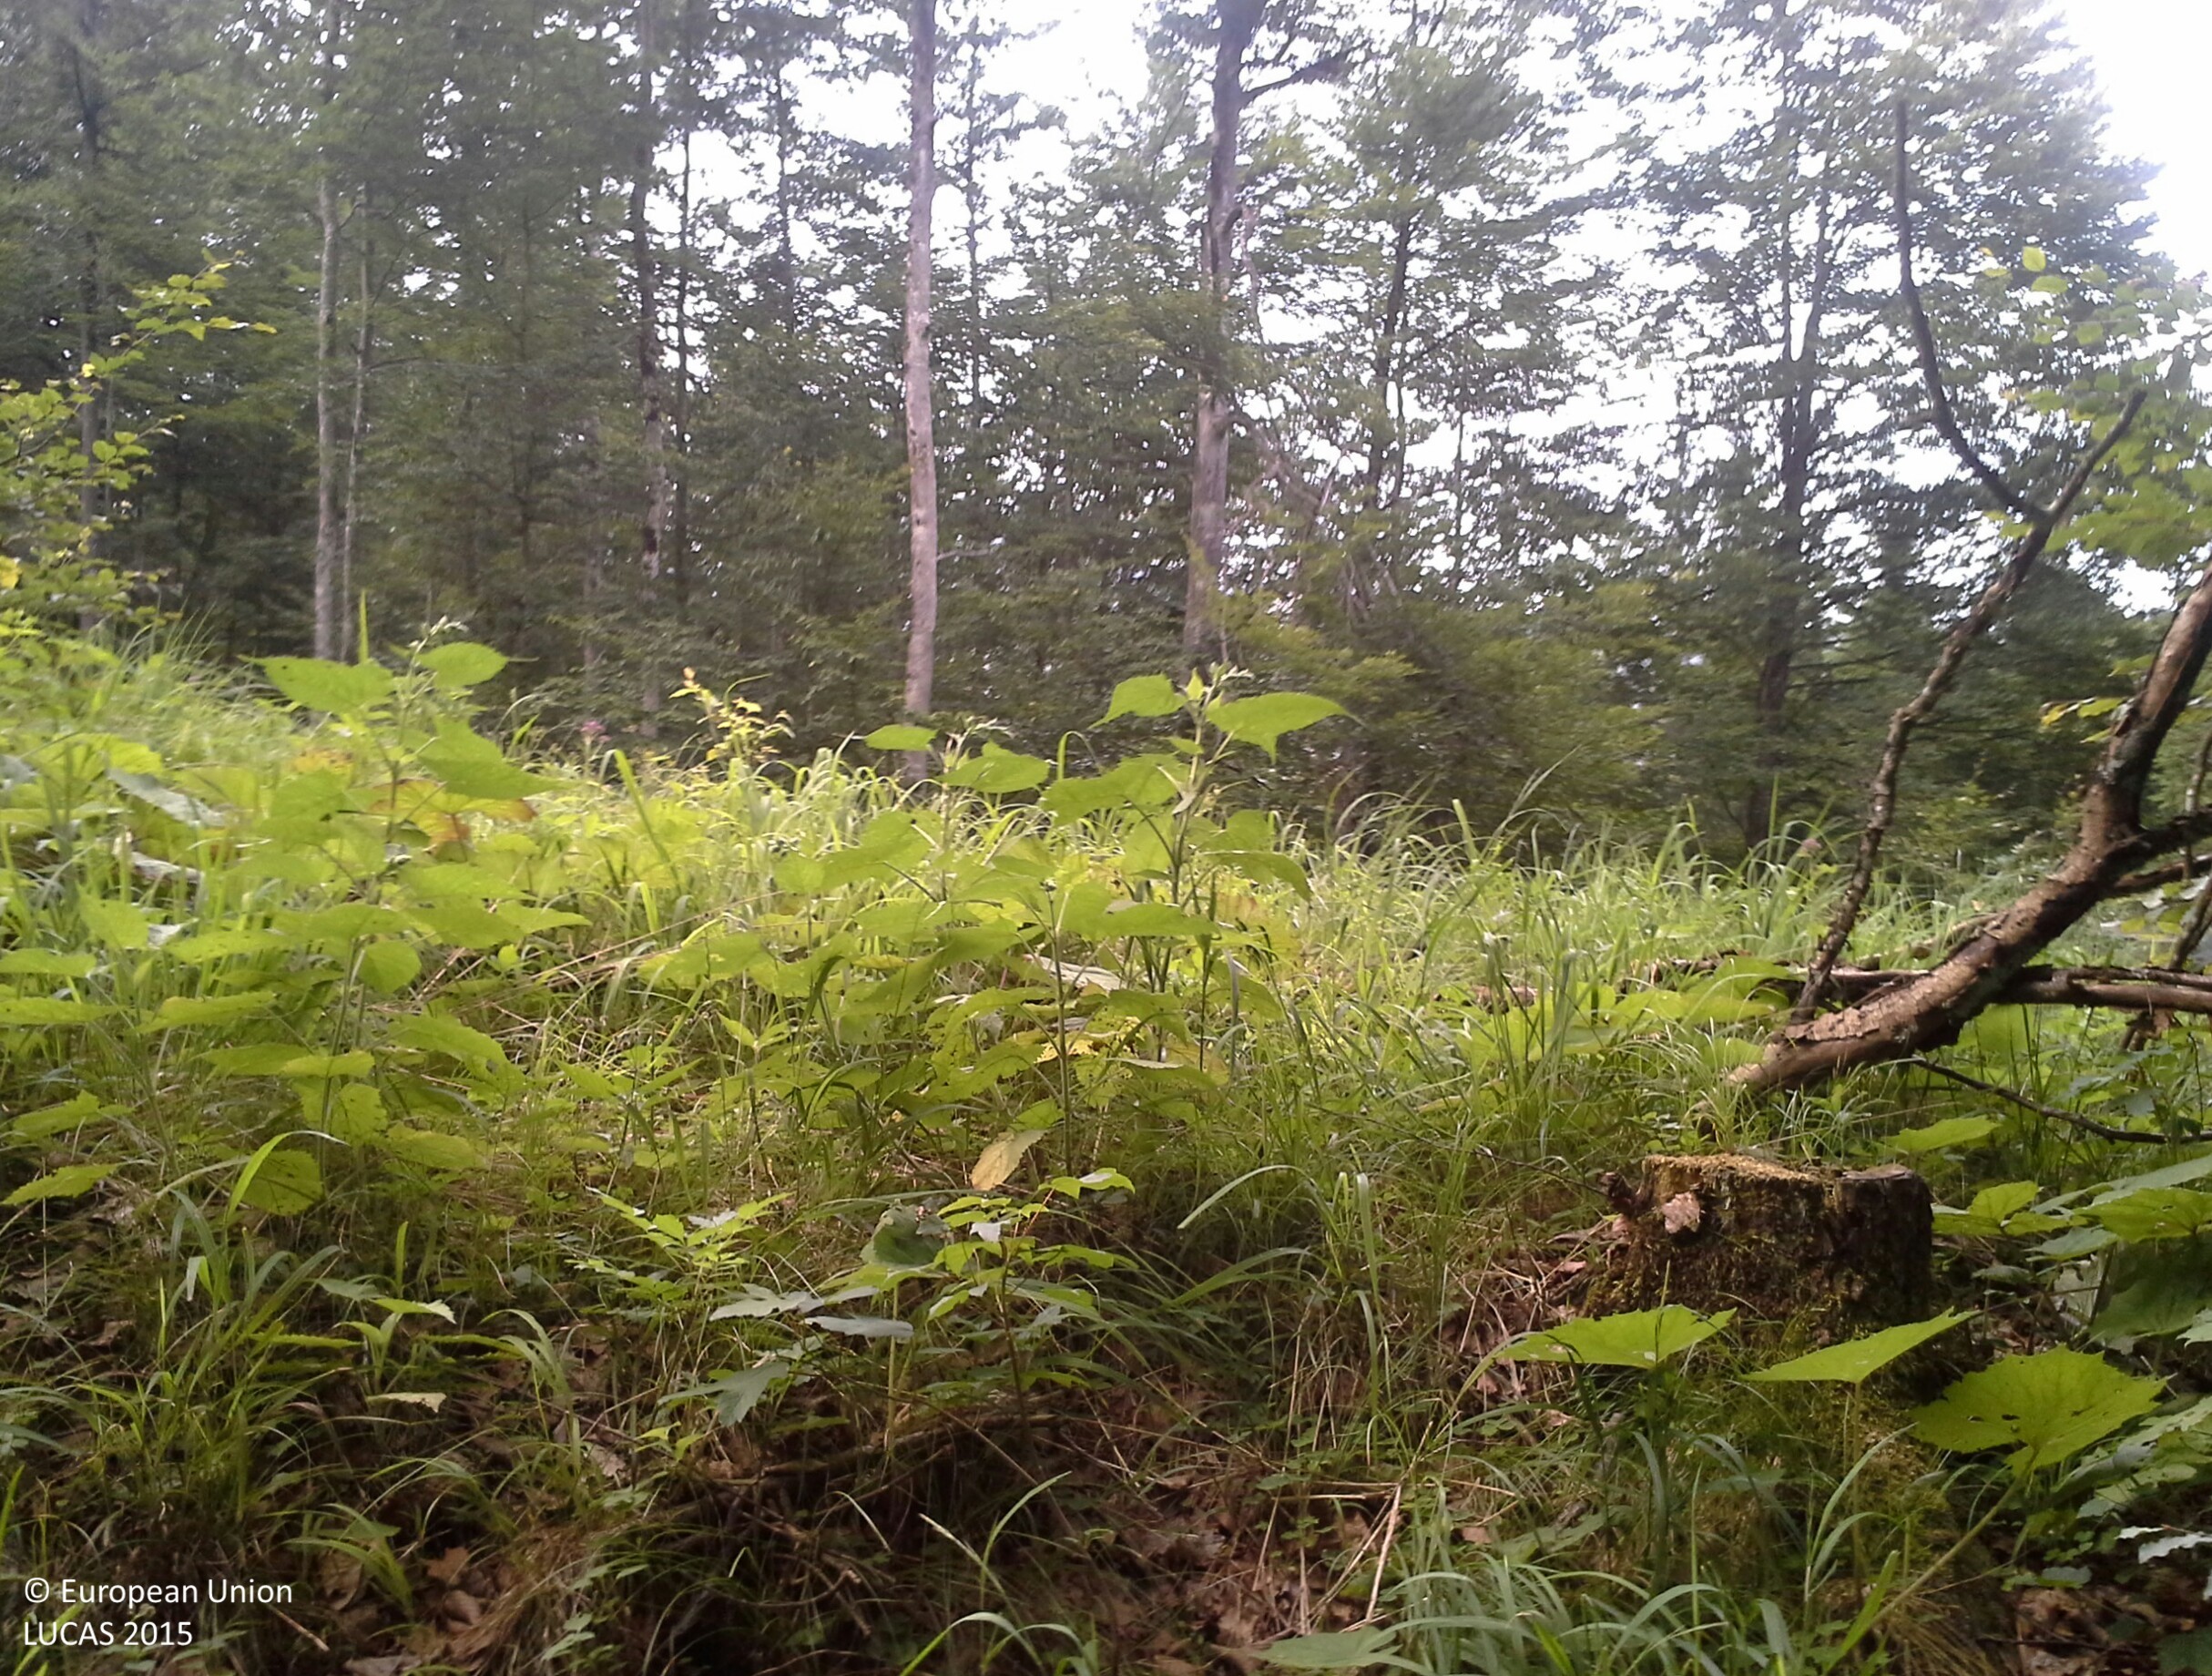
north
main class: Woodland
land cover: Broadleaved woodland
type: mountainous beech forest
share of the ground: > 75 %
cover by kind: broadleaved forest trees 90 %, coniferous forest trees 5 %, shrubs 5 %
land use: Forestry
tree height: > 5 m
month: July
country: AT
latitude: 47.7541
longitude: 14.0143
